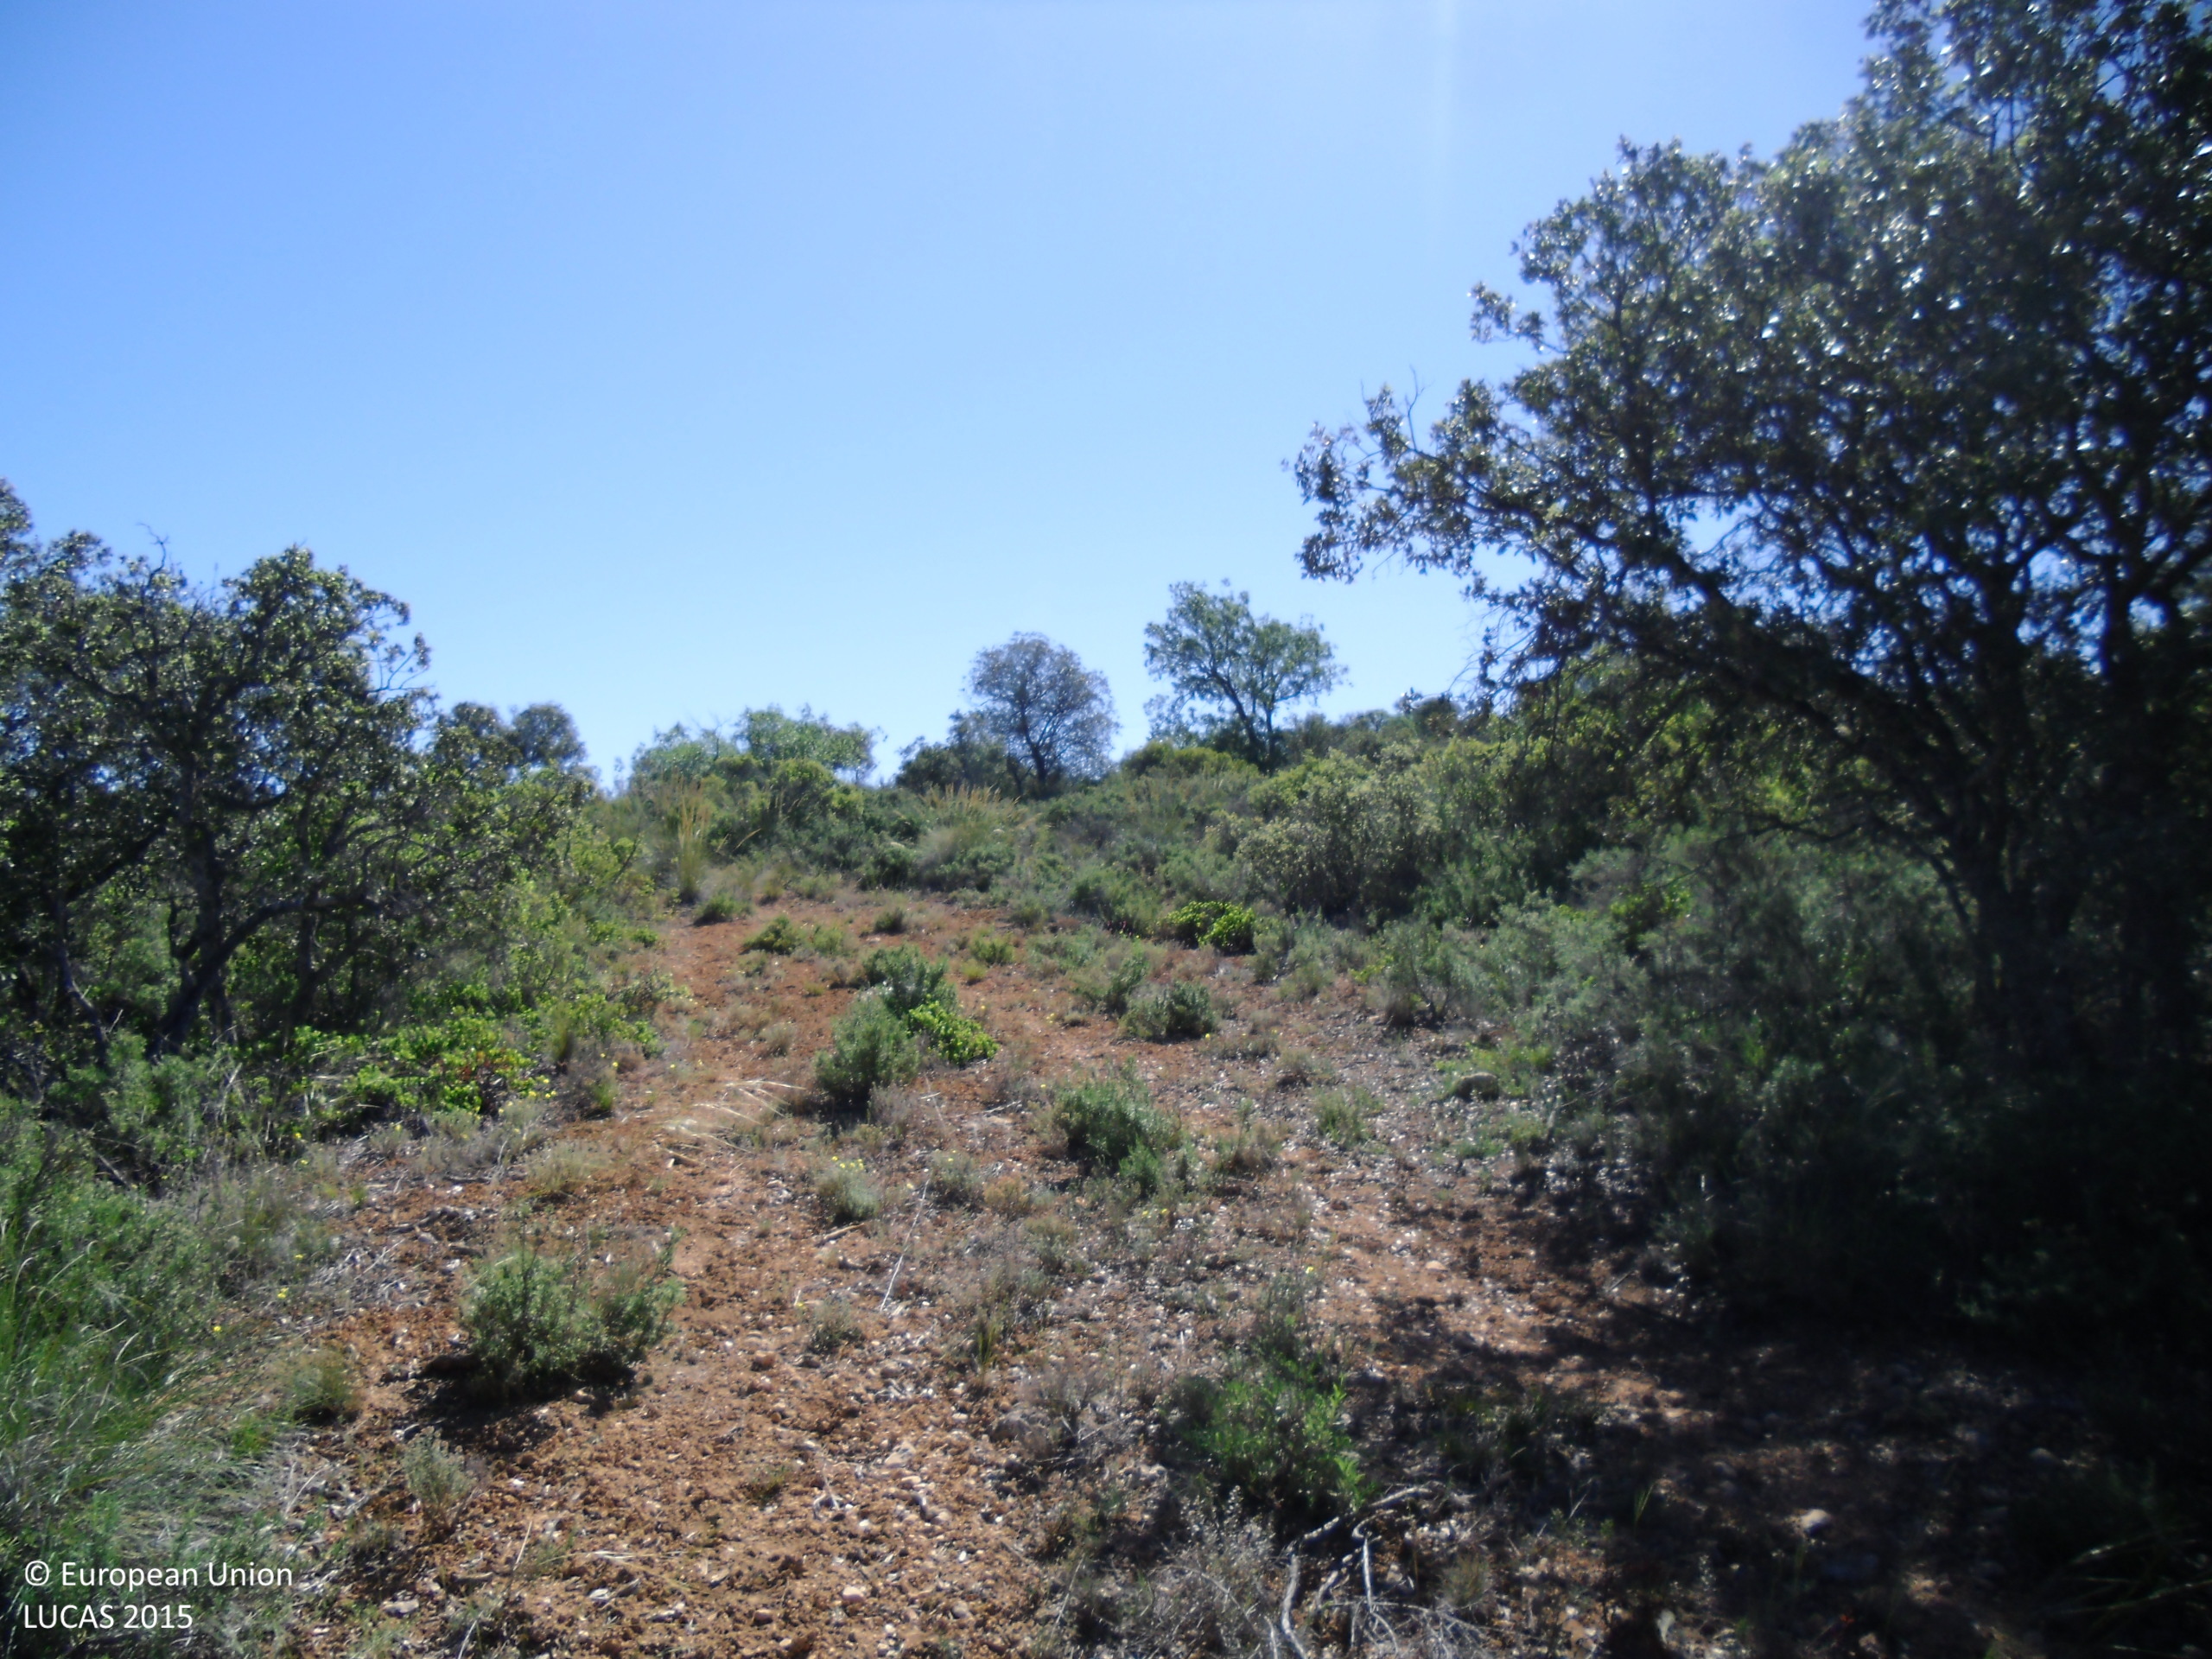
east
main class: Woodland
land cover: Broadleaved woodland
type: broadleaved evergreen forest
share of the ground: > 75 %
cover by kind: broadleaved forest trees 80 %, shrubs 10 %, herbaceous plants 5 %, consolidated bare surface 5 %
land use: Semi-natural and natural areas not in use
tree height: > 5 m
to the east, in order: Broadleaved woodland; Tracks; Broadleaved woodland; Tracks; Broadleaved woodland; Electric lines; Broadleaved woodland
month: May
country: ES
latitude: 40.1822
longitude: -2.8849
